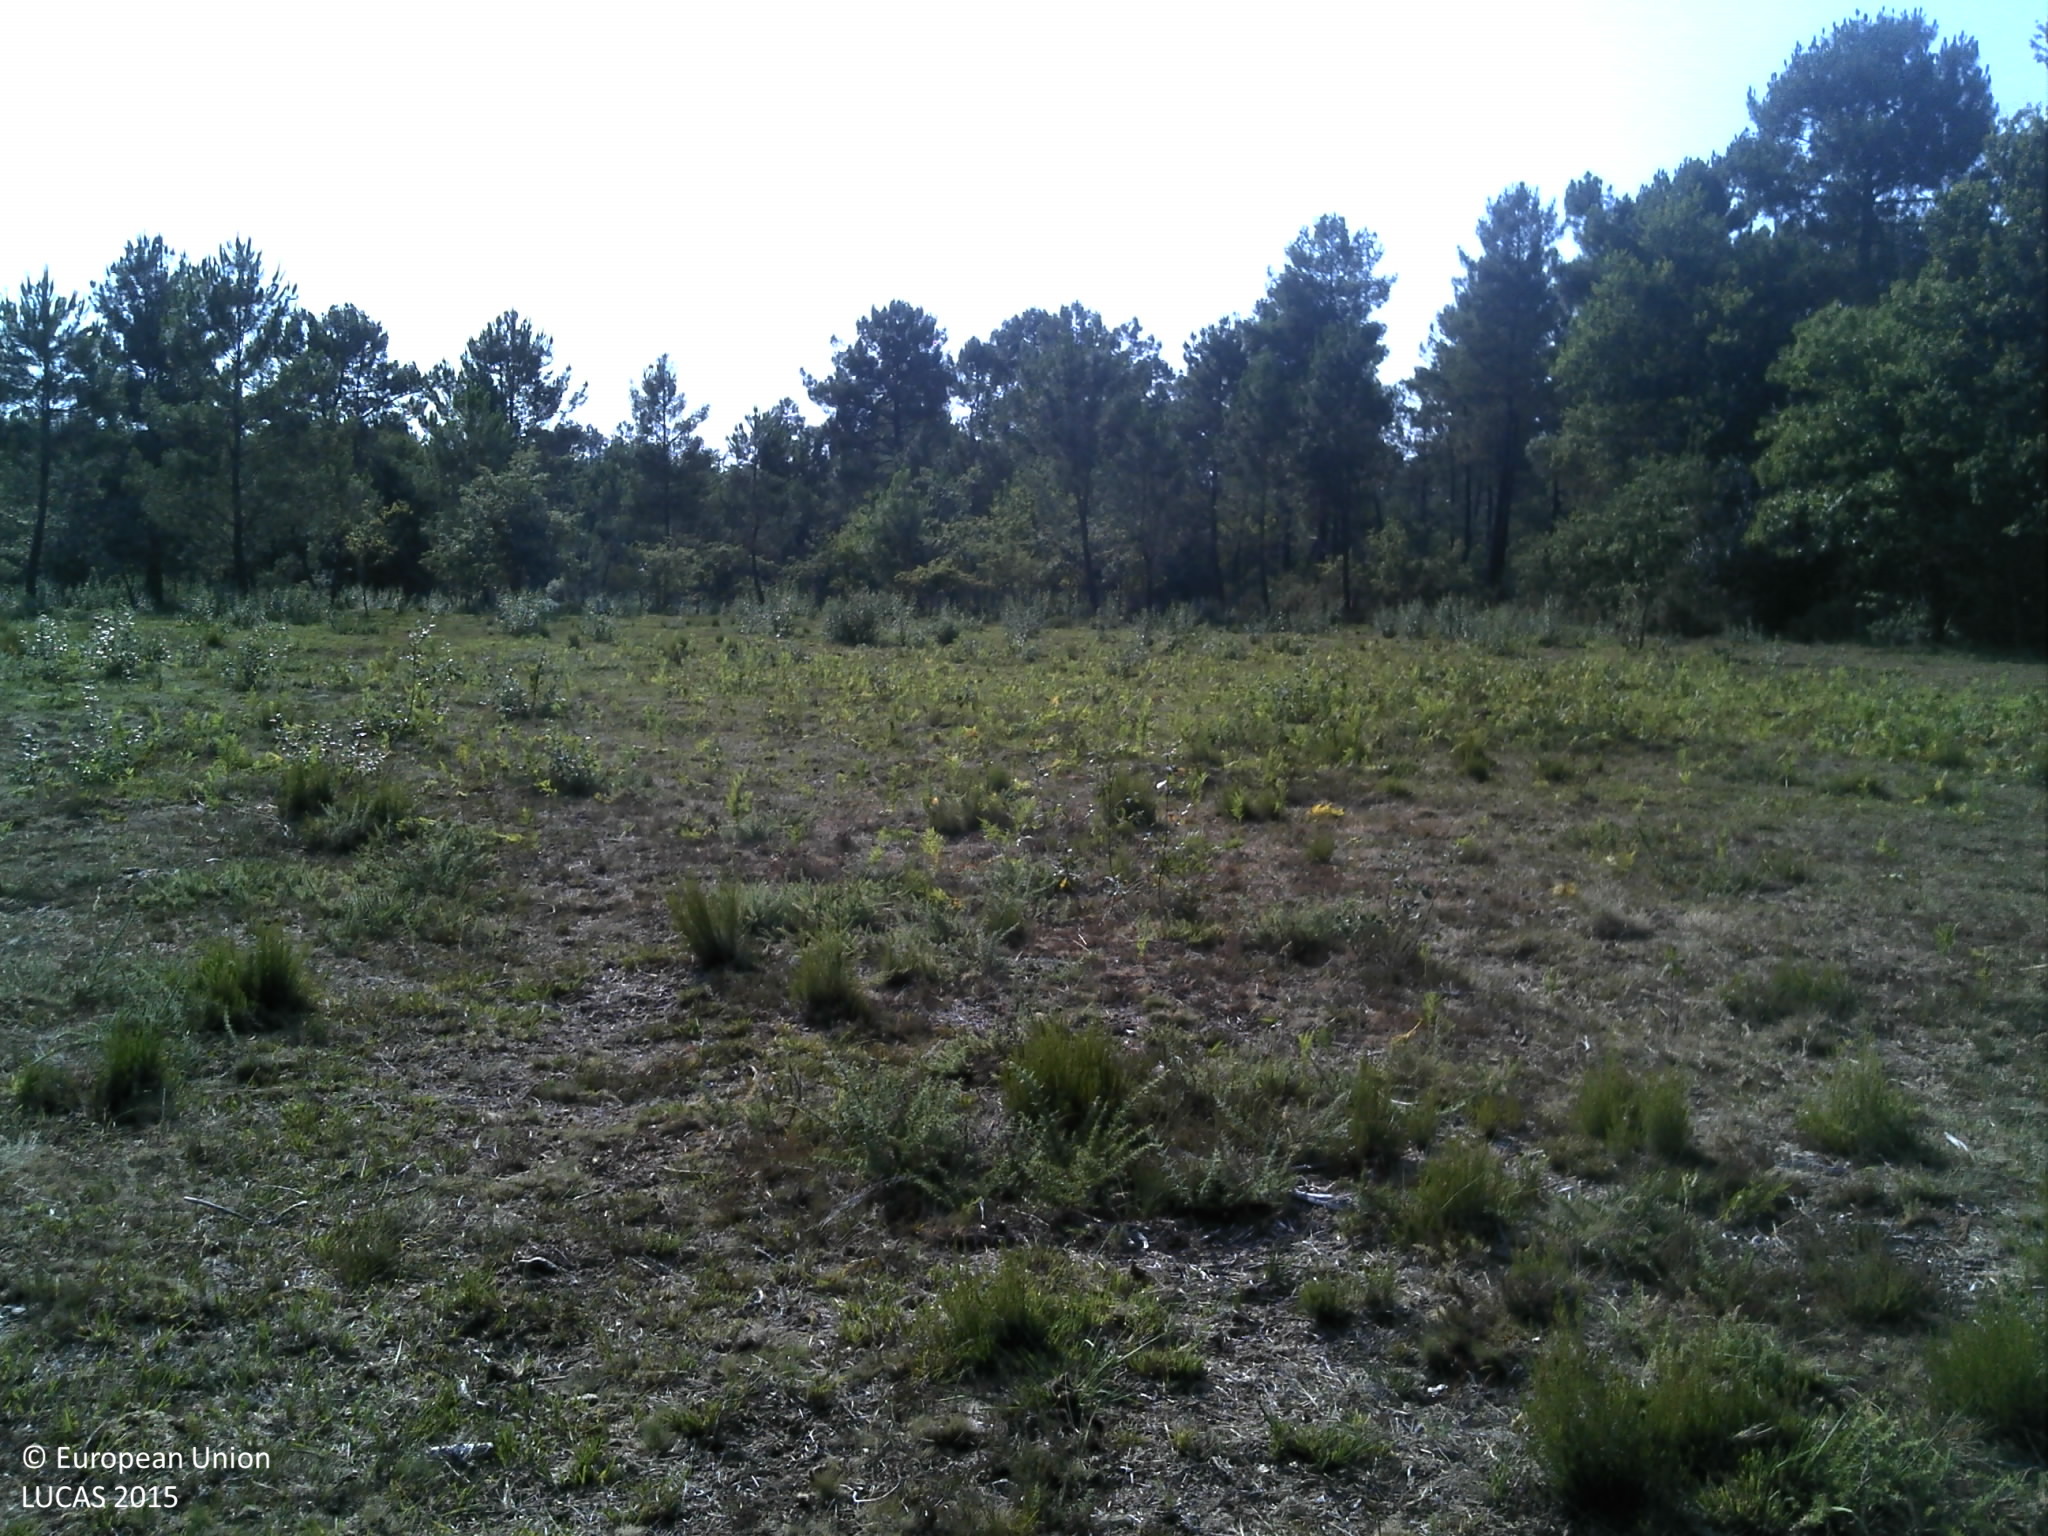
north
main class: Grassland
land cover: Spontaneously vegetated surfaces
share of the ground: > 75 %
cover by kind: herbaceous plants 95 %, shrubs 5 %
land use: Semi-natural and natural areas not in use
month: July
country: FR
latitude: 44.5840
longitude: -0.4572
